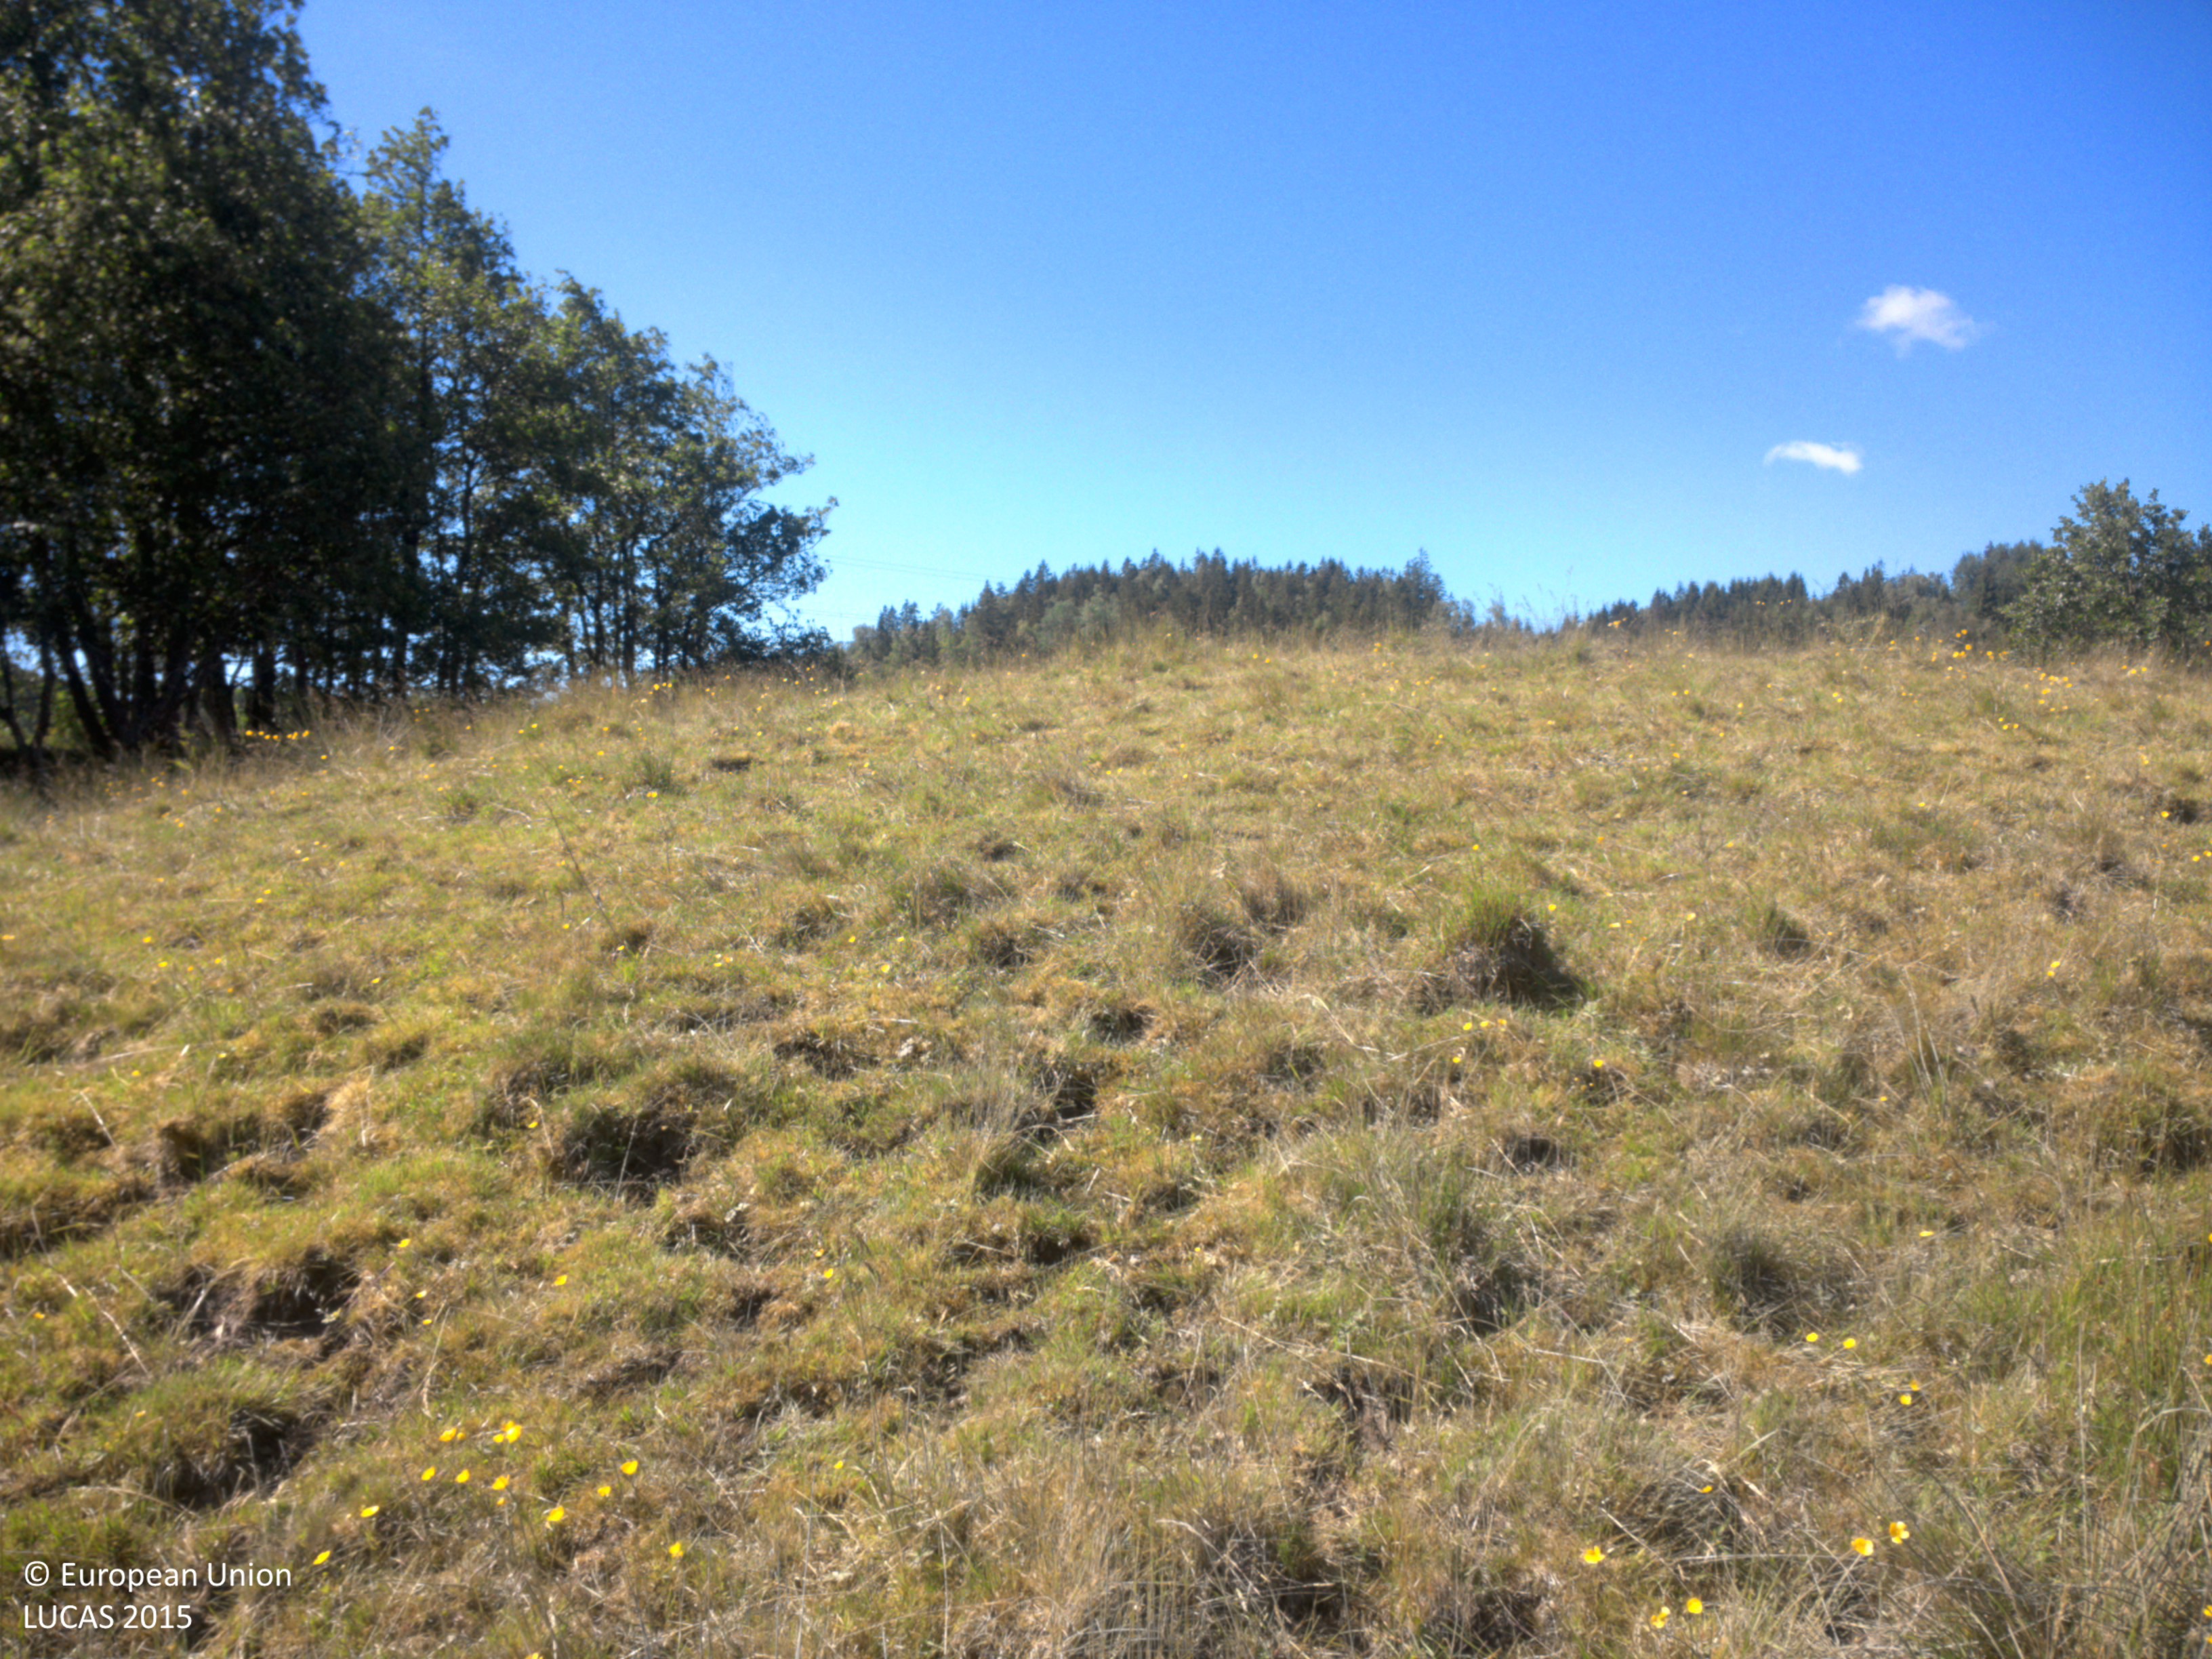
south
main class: Grassland
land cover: Grassland with sparse tree/shrub cover
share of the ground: > 75 %
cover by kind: herbaceous plants 95 %, broadleaved forest trees 5 %
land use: Agriculture (excluding fallow land and kitchen gardens)
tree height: > 5 m
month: June
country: SE
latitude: 58.4979
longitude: 11.5923
